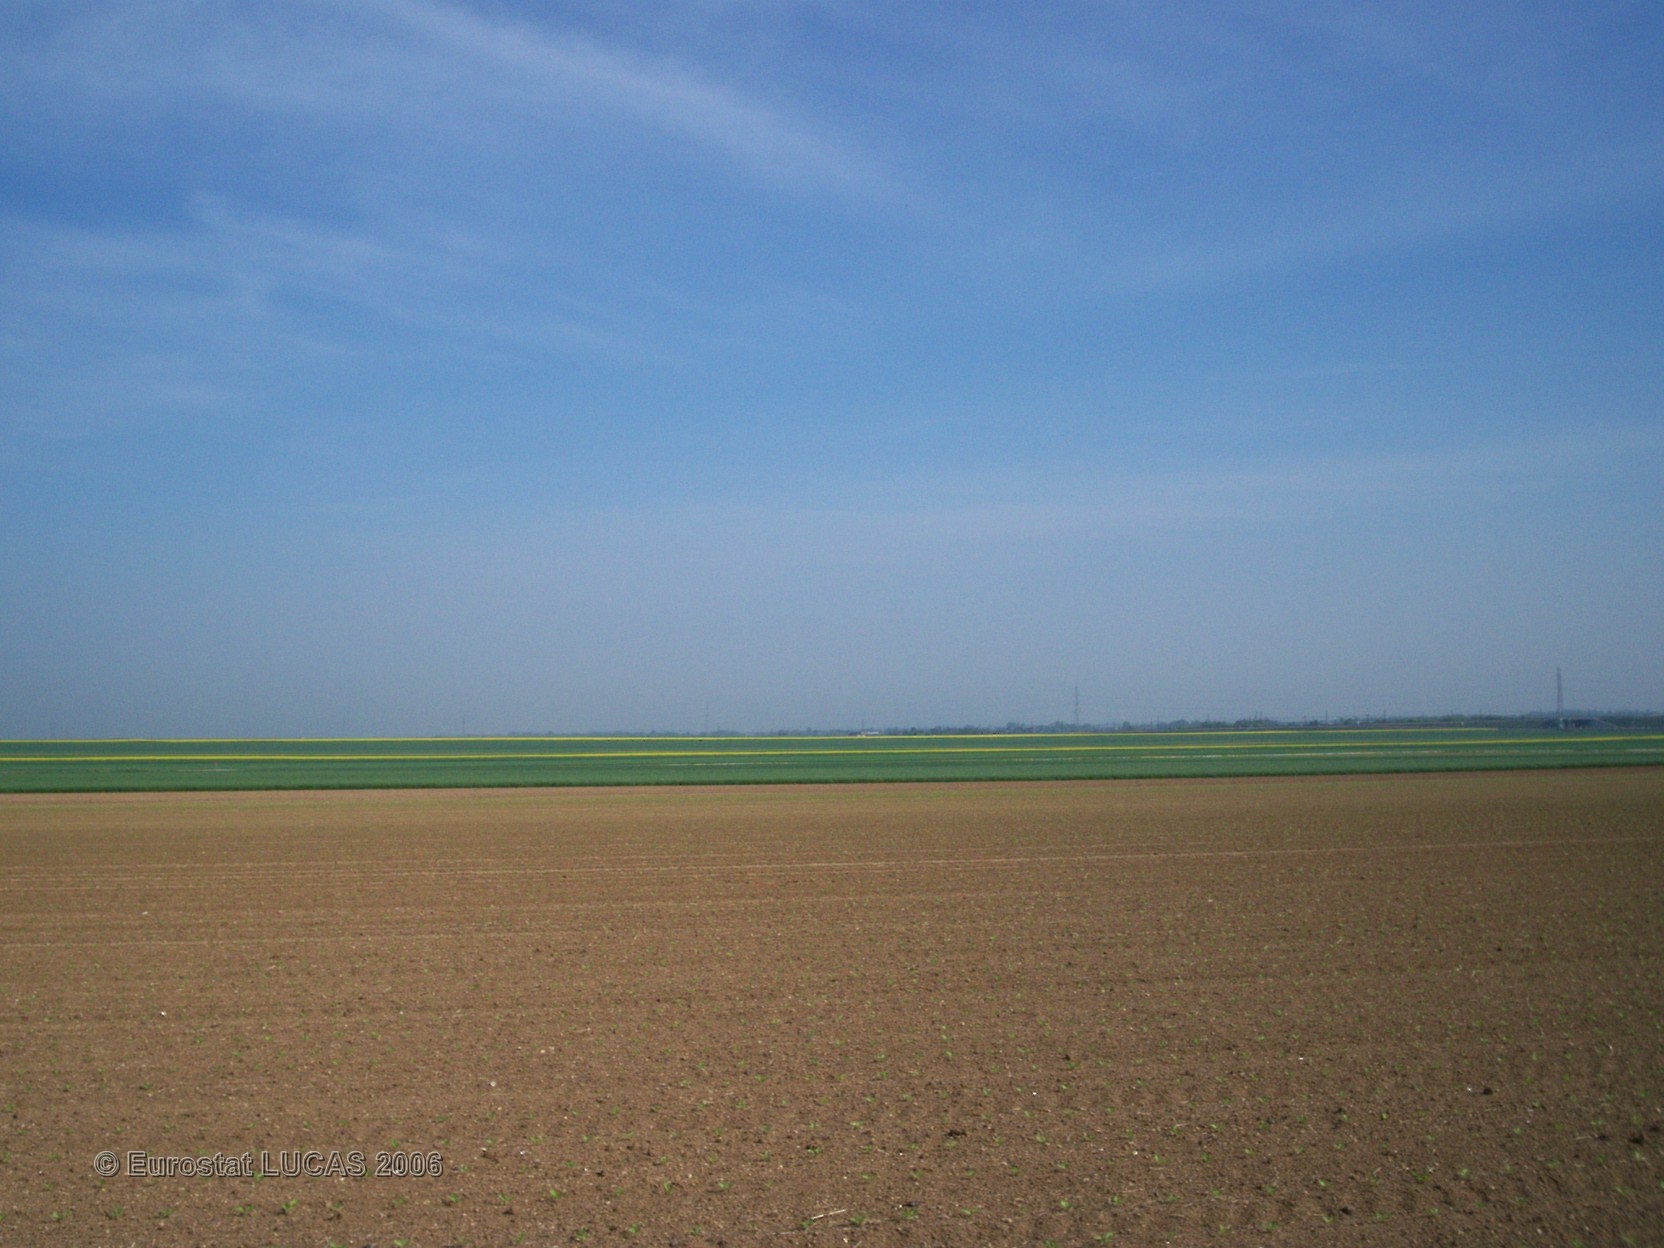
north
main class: Cropland
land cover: Sugar beet
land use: Agriculture (excluding fallow land and kitchen gardens)
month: May
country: FR
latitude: 49.0537
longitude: 4.3723
